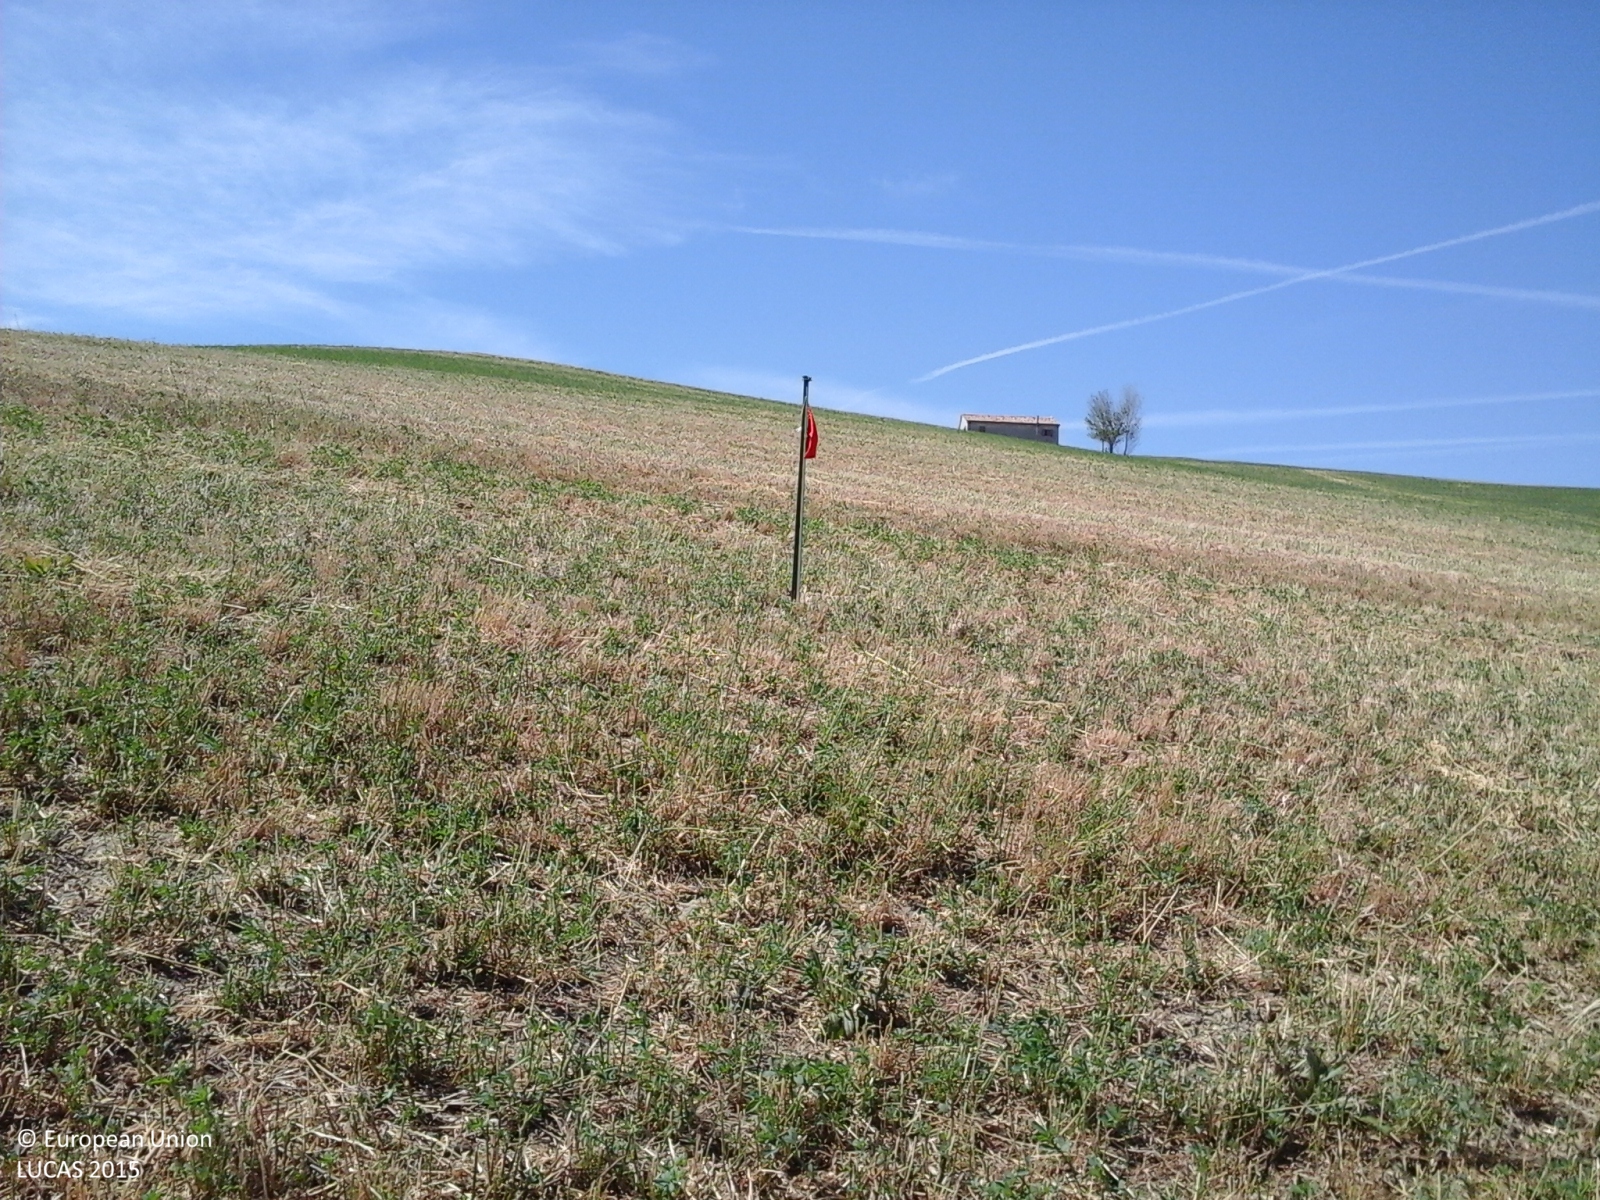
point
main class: Cropland
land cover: Lucerne
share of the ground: > 75 %
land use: Agriculture (excluding fallow land and kitchen gardens)
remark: Harvested field
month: July
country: IT
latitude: 43.8824
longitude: 12.6945
